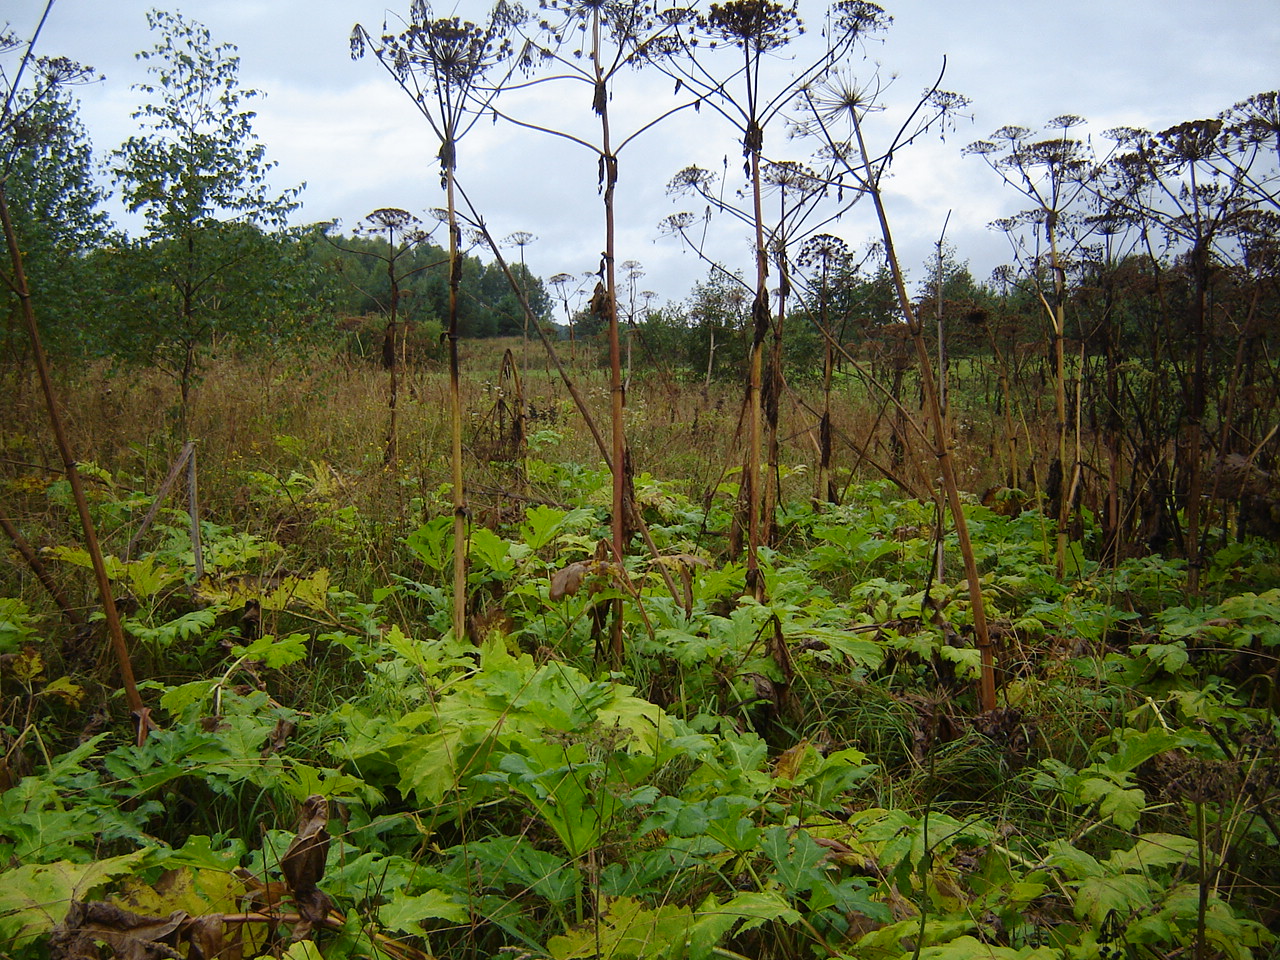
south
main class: Woodland
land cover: Pine dominated mixed woodland
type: hemiboreal forest and nemoral coniferous forest and mixed broadleaved-coniferous forest
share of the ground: > 75 %
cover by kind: broadleaved forest trees 55 %, coniferous forest trees 30 %, herbaceous plants 15 %
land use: Forestry
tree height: > 5 m
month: September
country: LT
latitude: 54.9976
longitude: 25.3638
